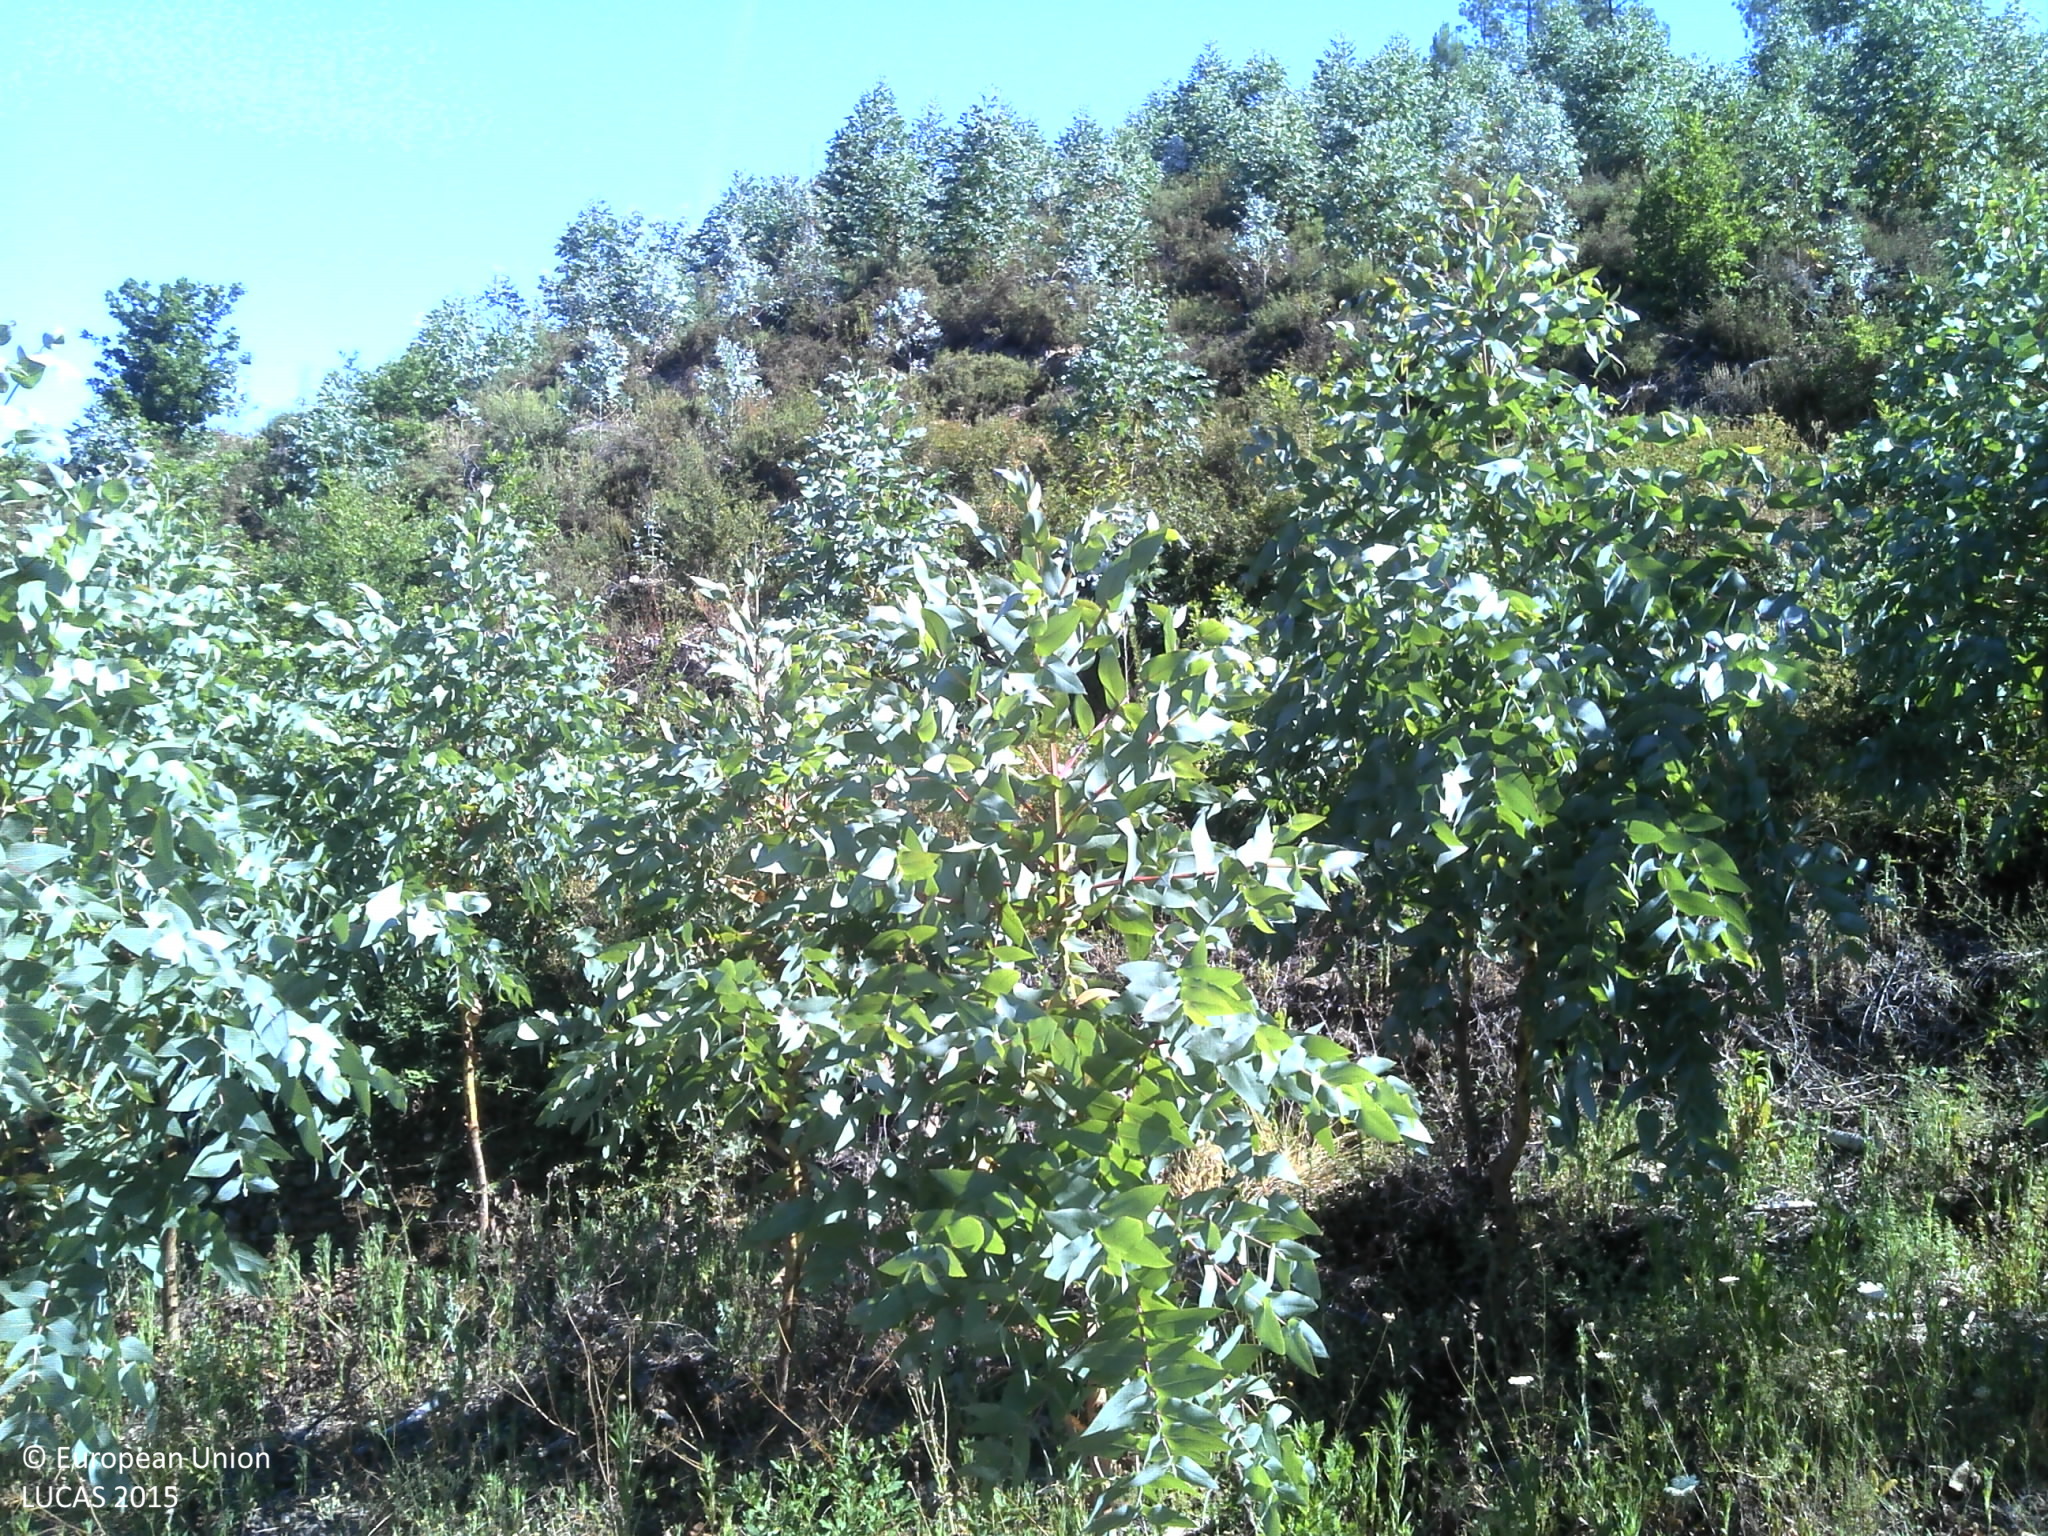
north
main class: Woodland
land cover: Broadleaved woodland
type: exotic forest
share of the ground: 10 - 25 %
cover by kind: unconsolidated bare surface 50 %, broadleaved forest trees 25 %, shrubs 15 %, herbaceous plants 10 %
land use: Forestry
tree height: < 5 m
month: July
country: PT
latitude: 40.2285
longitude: -8.1154
